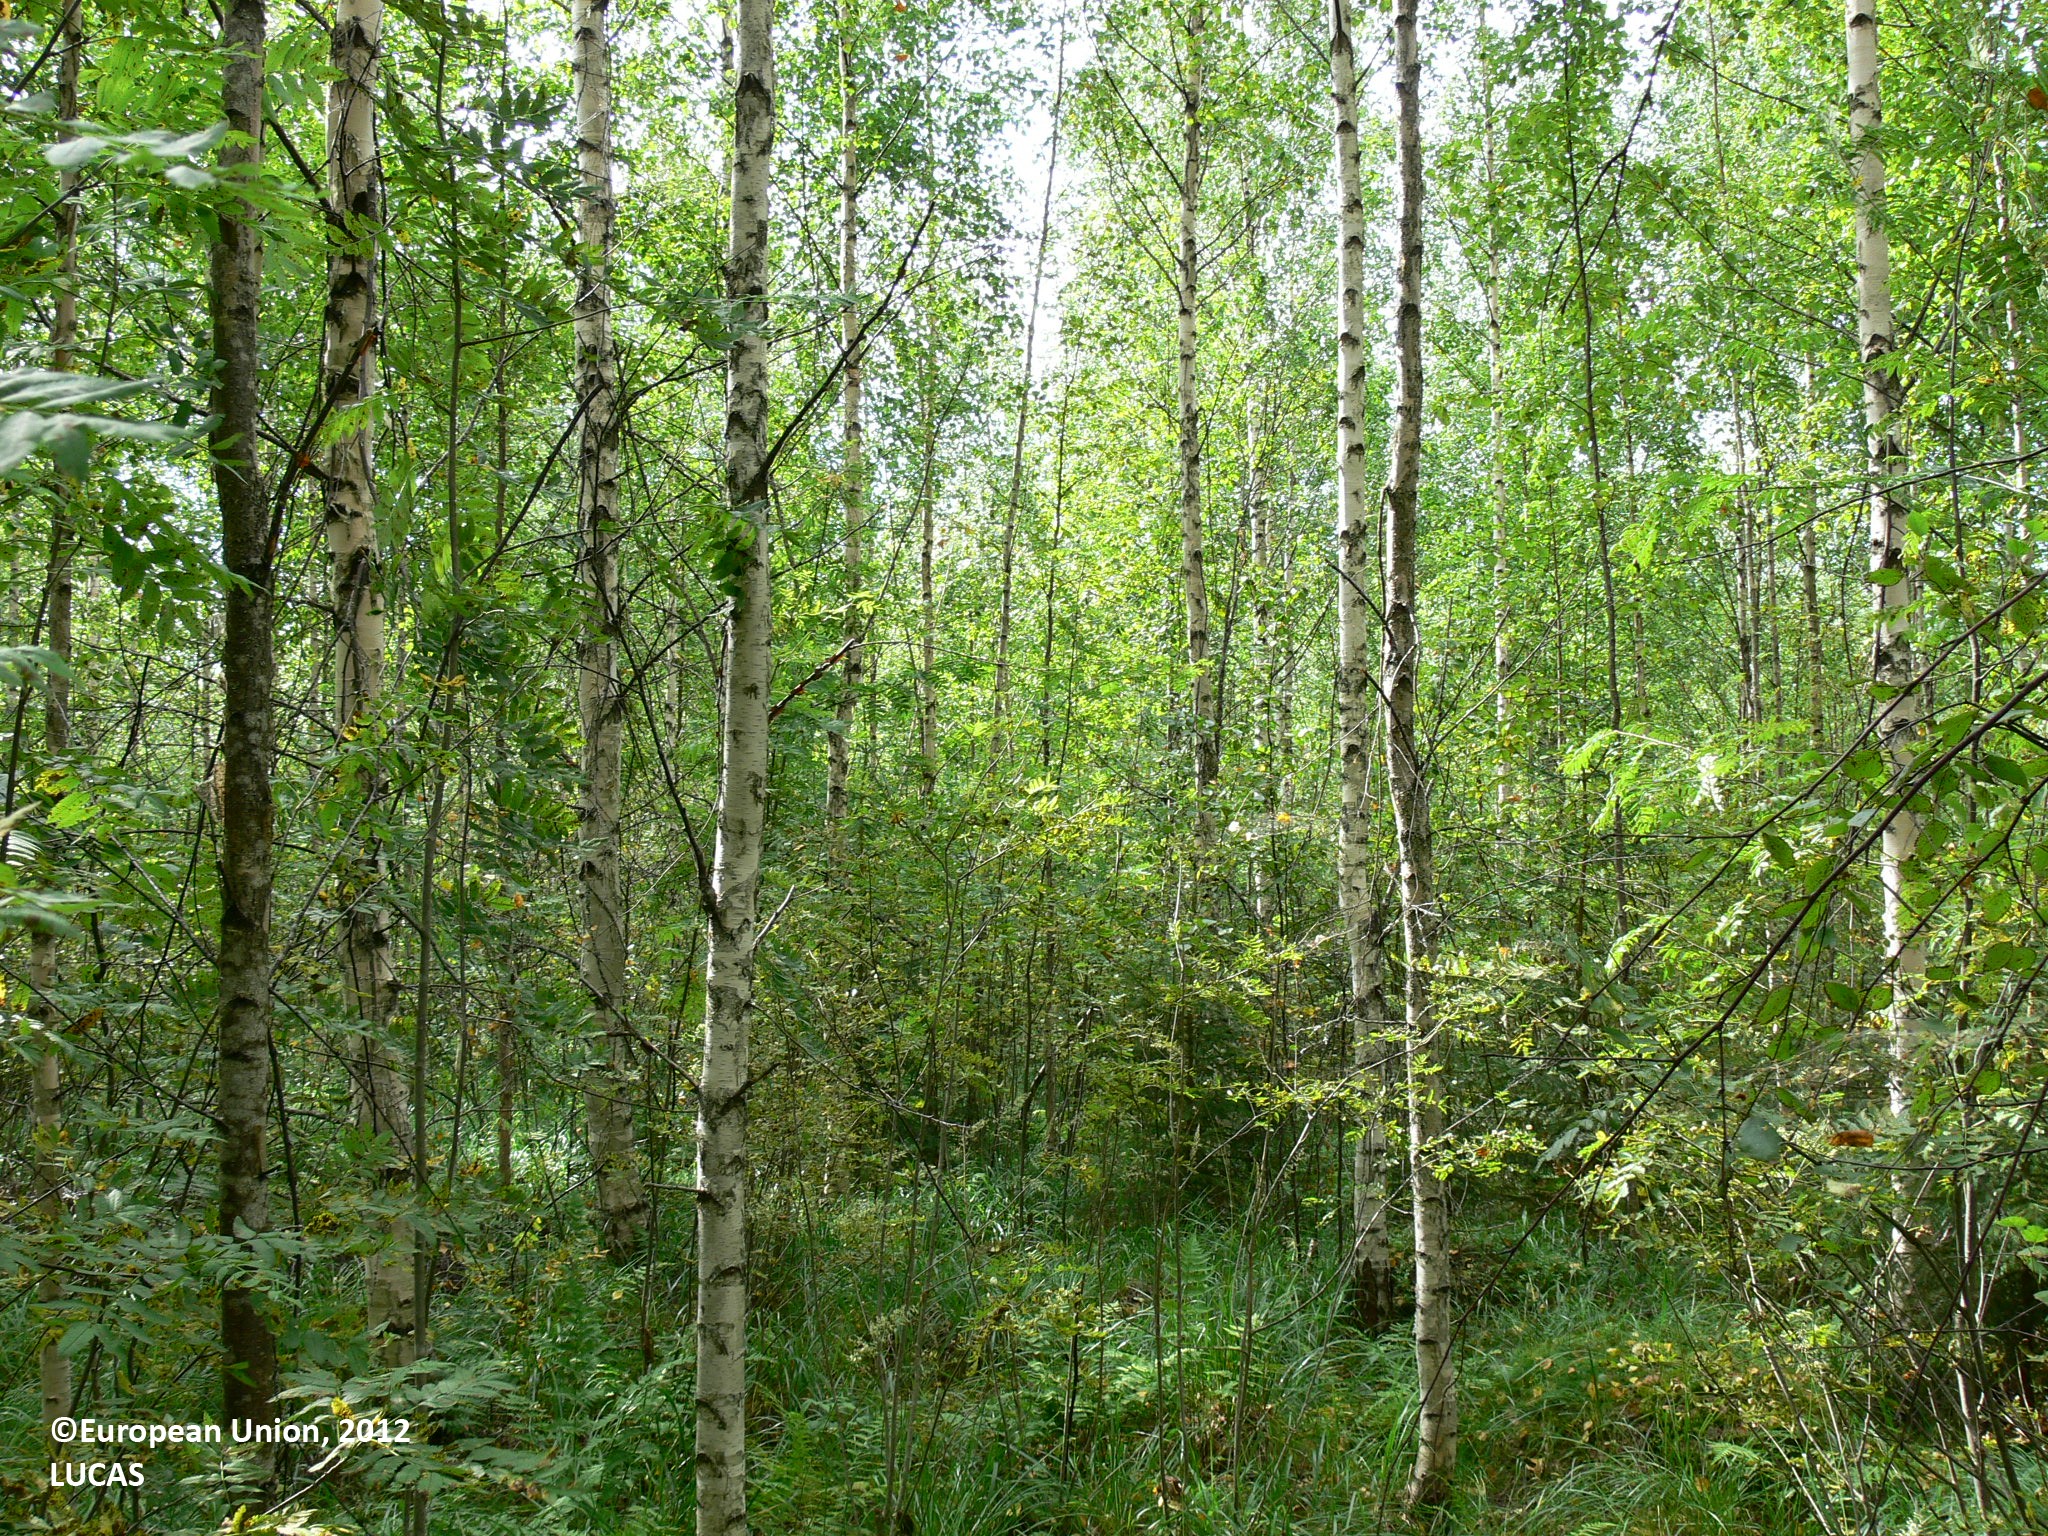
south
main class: Woodland
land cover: Broadleaved woodland
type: boreal forest
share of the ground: > 75 %
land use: Forestry
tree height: > 5 m
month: August
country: FI
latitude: 62.4422
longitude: 30.6941
